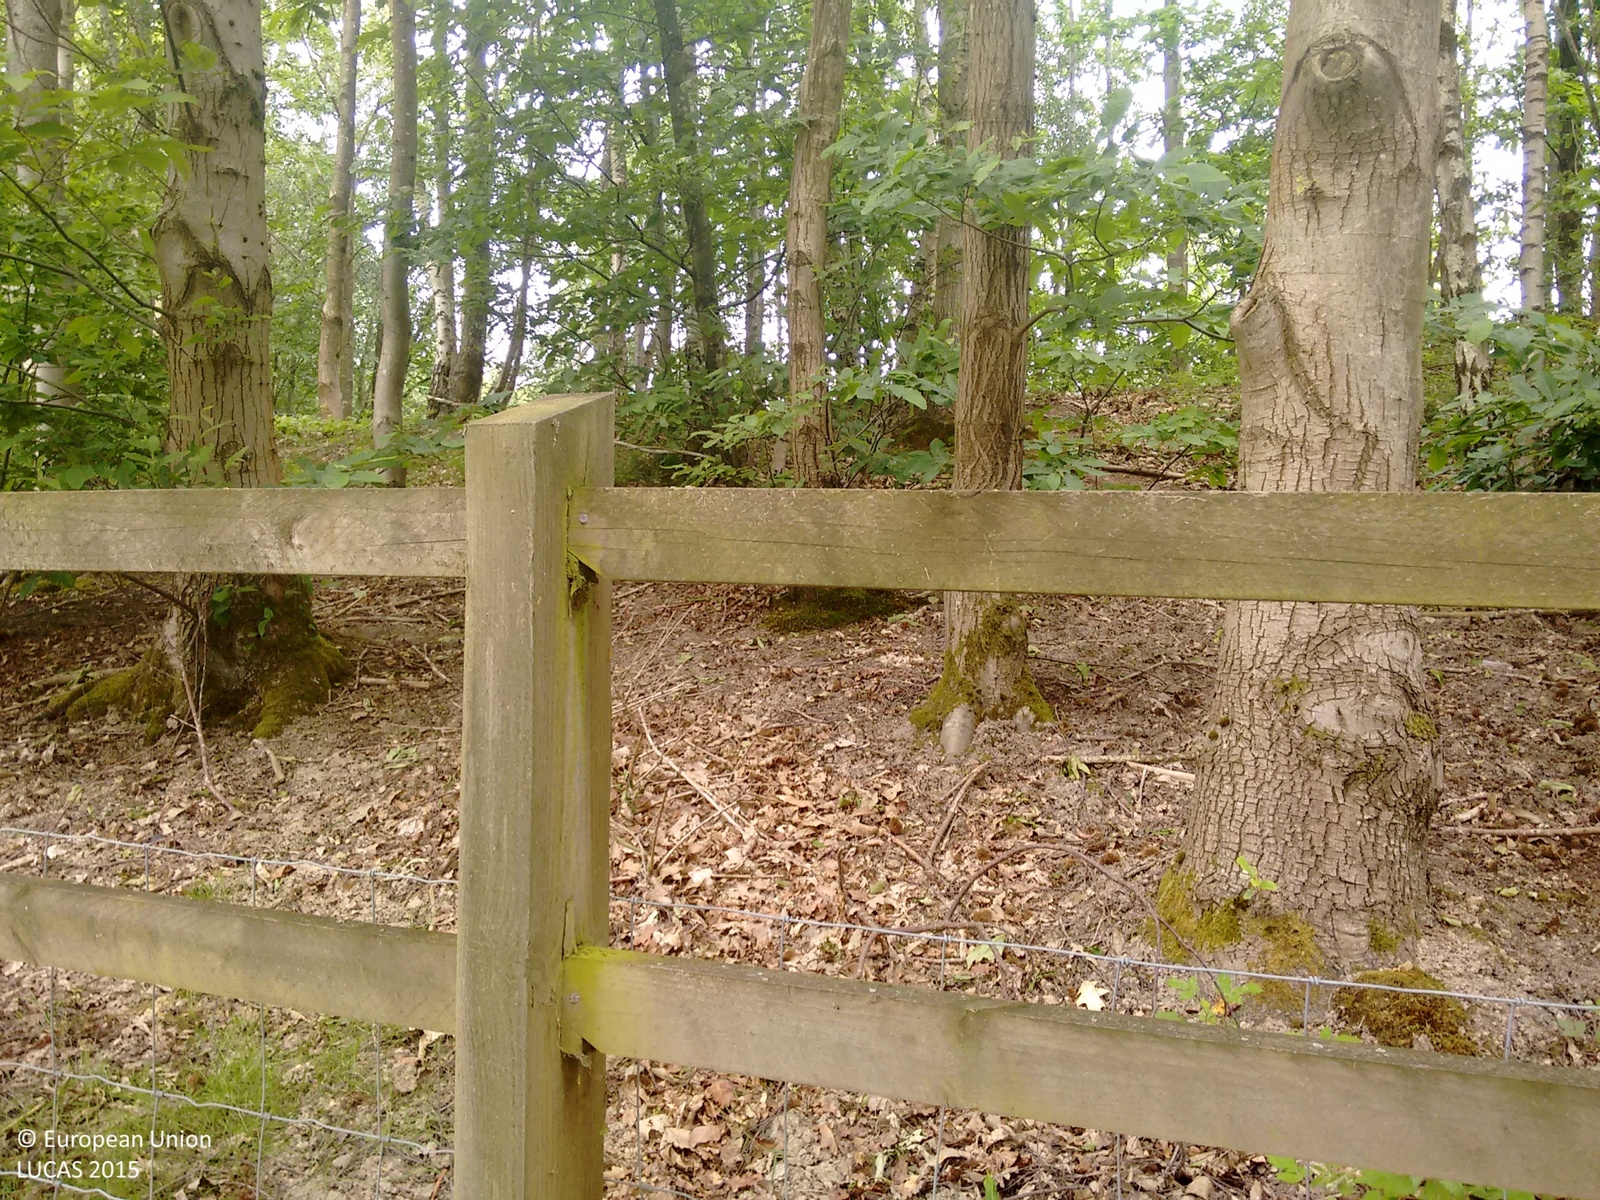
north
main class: Woodland
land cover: Broadleaved woodland
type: mesophytic deciduous forest
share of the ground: > 75 %
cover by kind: broadleaved forest trees 90 %, shrubs 10 %
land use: Waste treatment
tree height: > 5 m
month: June
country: GB
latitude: 51.0816
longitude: 0.3927
